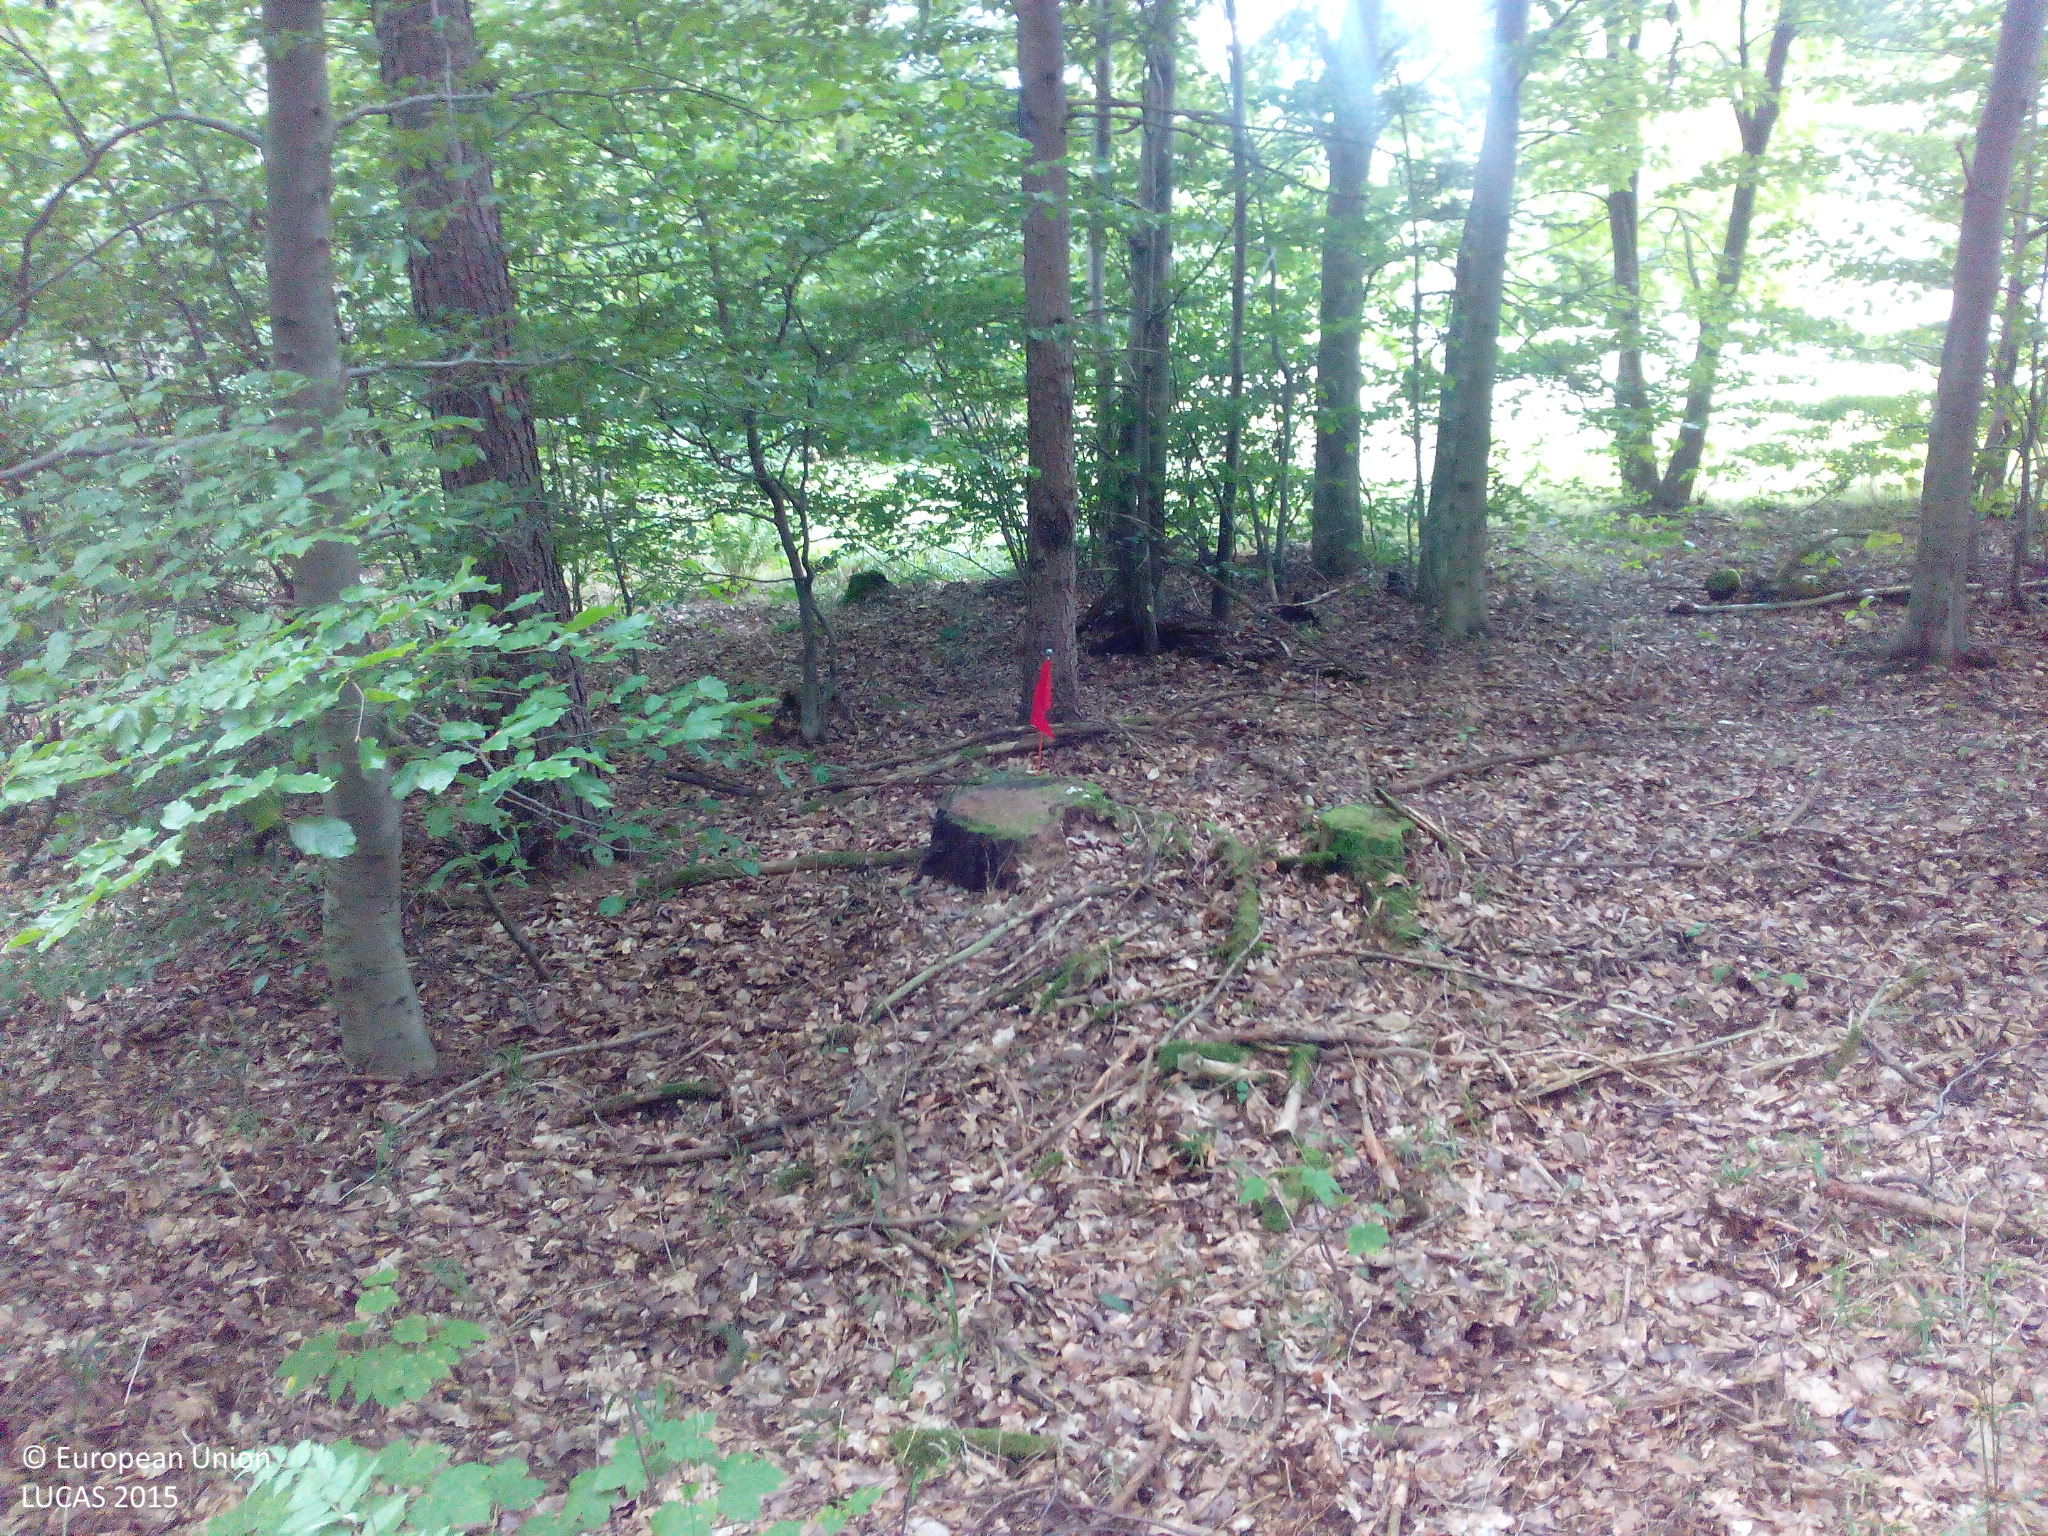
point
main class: Woodland
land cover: Other mixed woodland
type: hemiboreal forest and nemoral coniferous forest and mixed broadleaved-coniferous forest
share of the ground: > 75 %
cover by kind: coniferous forest trees 60 %, broadleaved forest trees 40 %
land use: Forestry
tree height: > 5 m
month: September
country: DE
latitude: 51.6535
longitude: 11.0838
